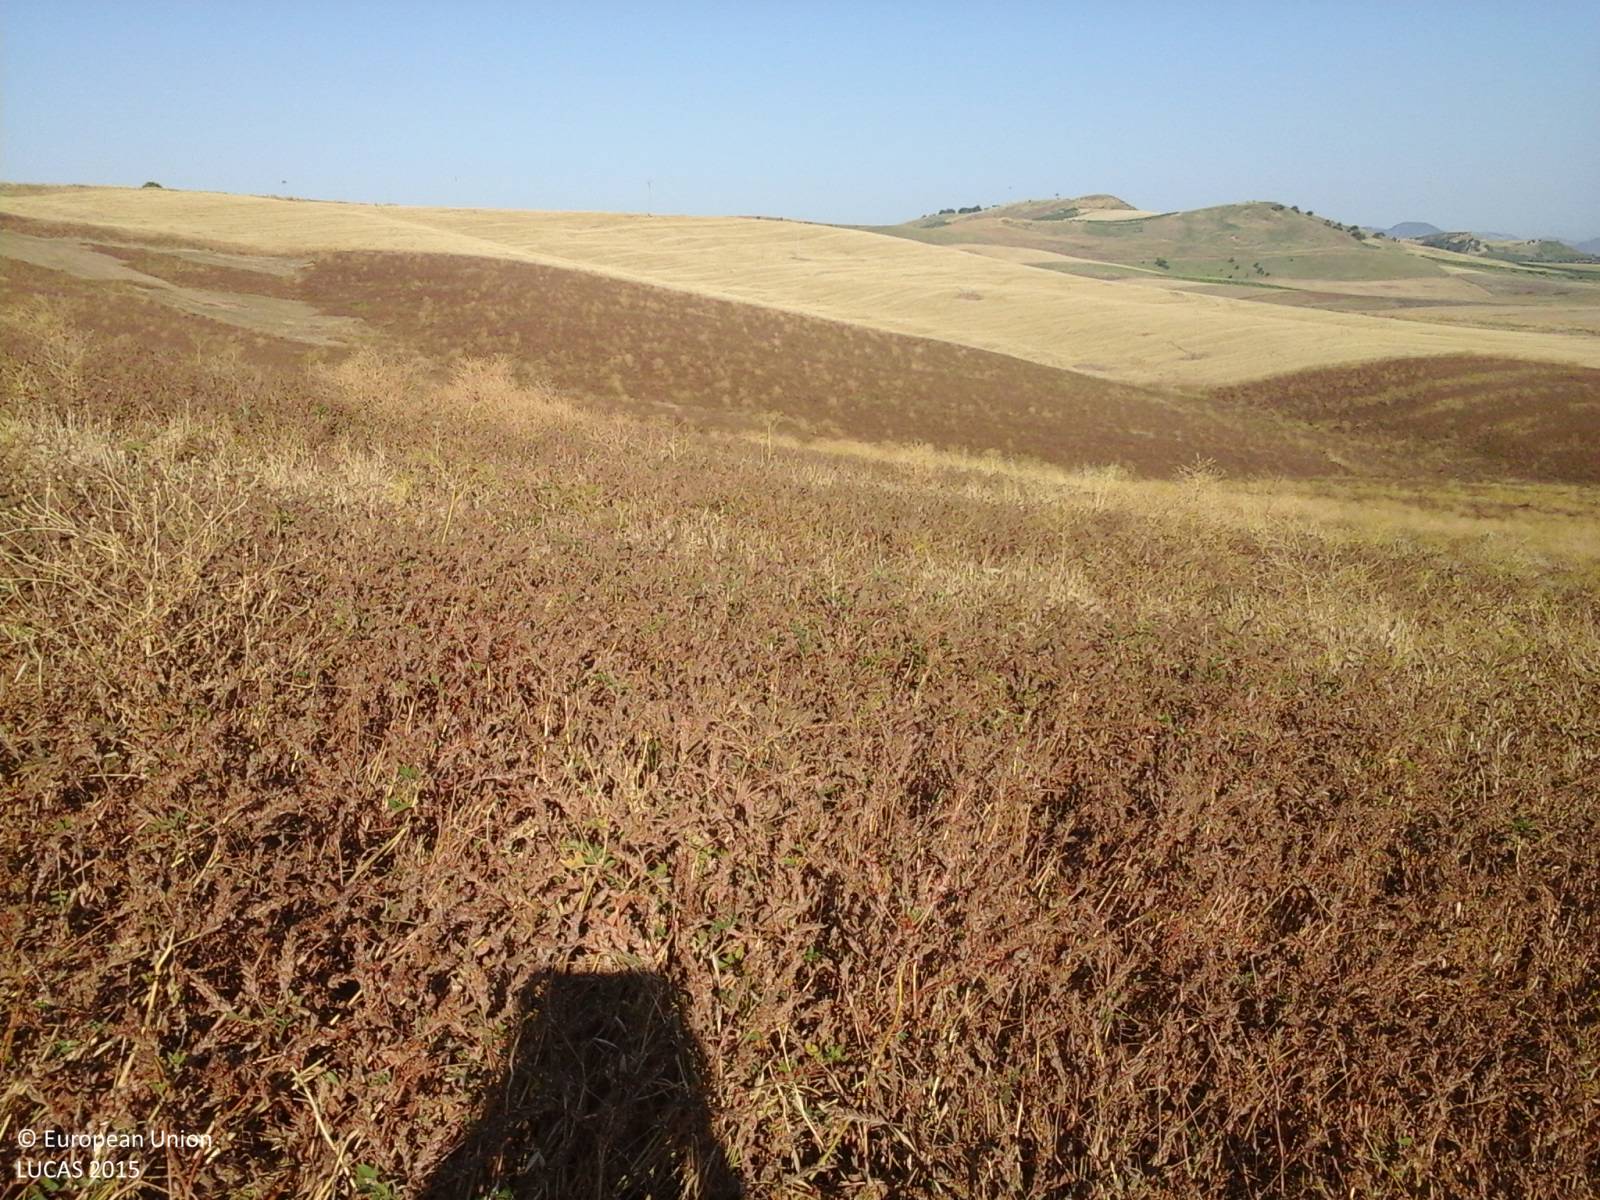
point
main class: Cropland
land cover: Other leguminous and mixtures for fodder
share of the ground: > 75 %
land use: Agriculture (excluding fallow land and kitchen gardens)
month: July
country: IT
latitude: 37.8814
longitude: 13.0137
